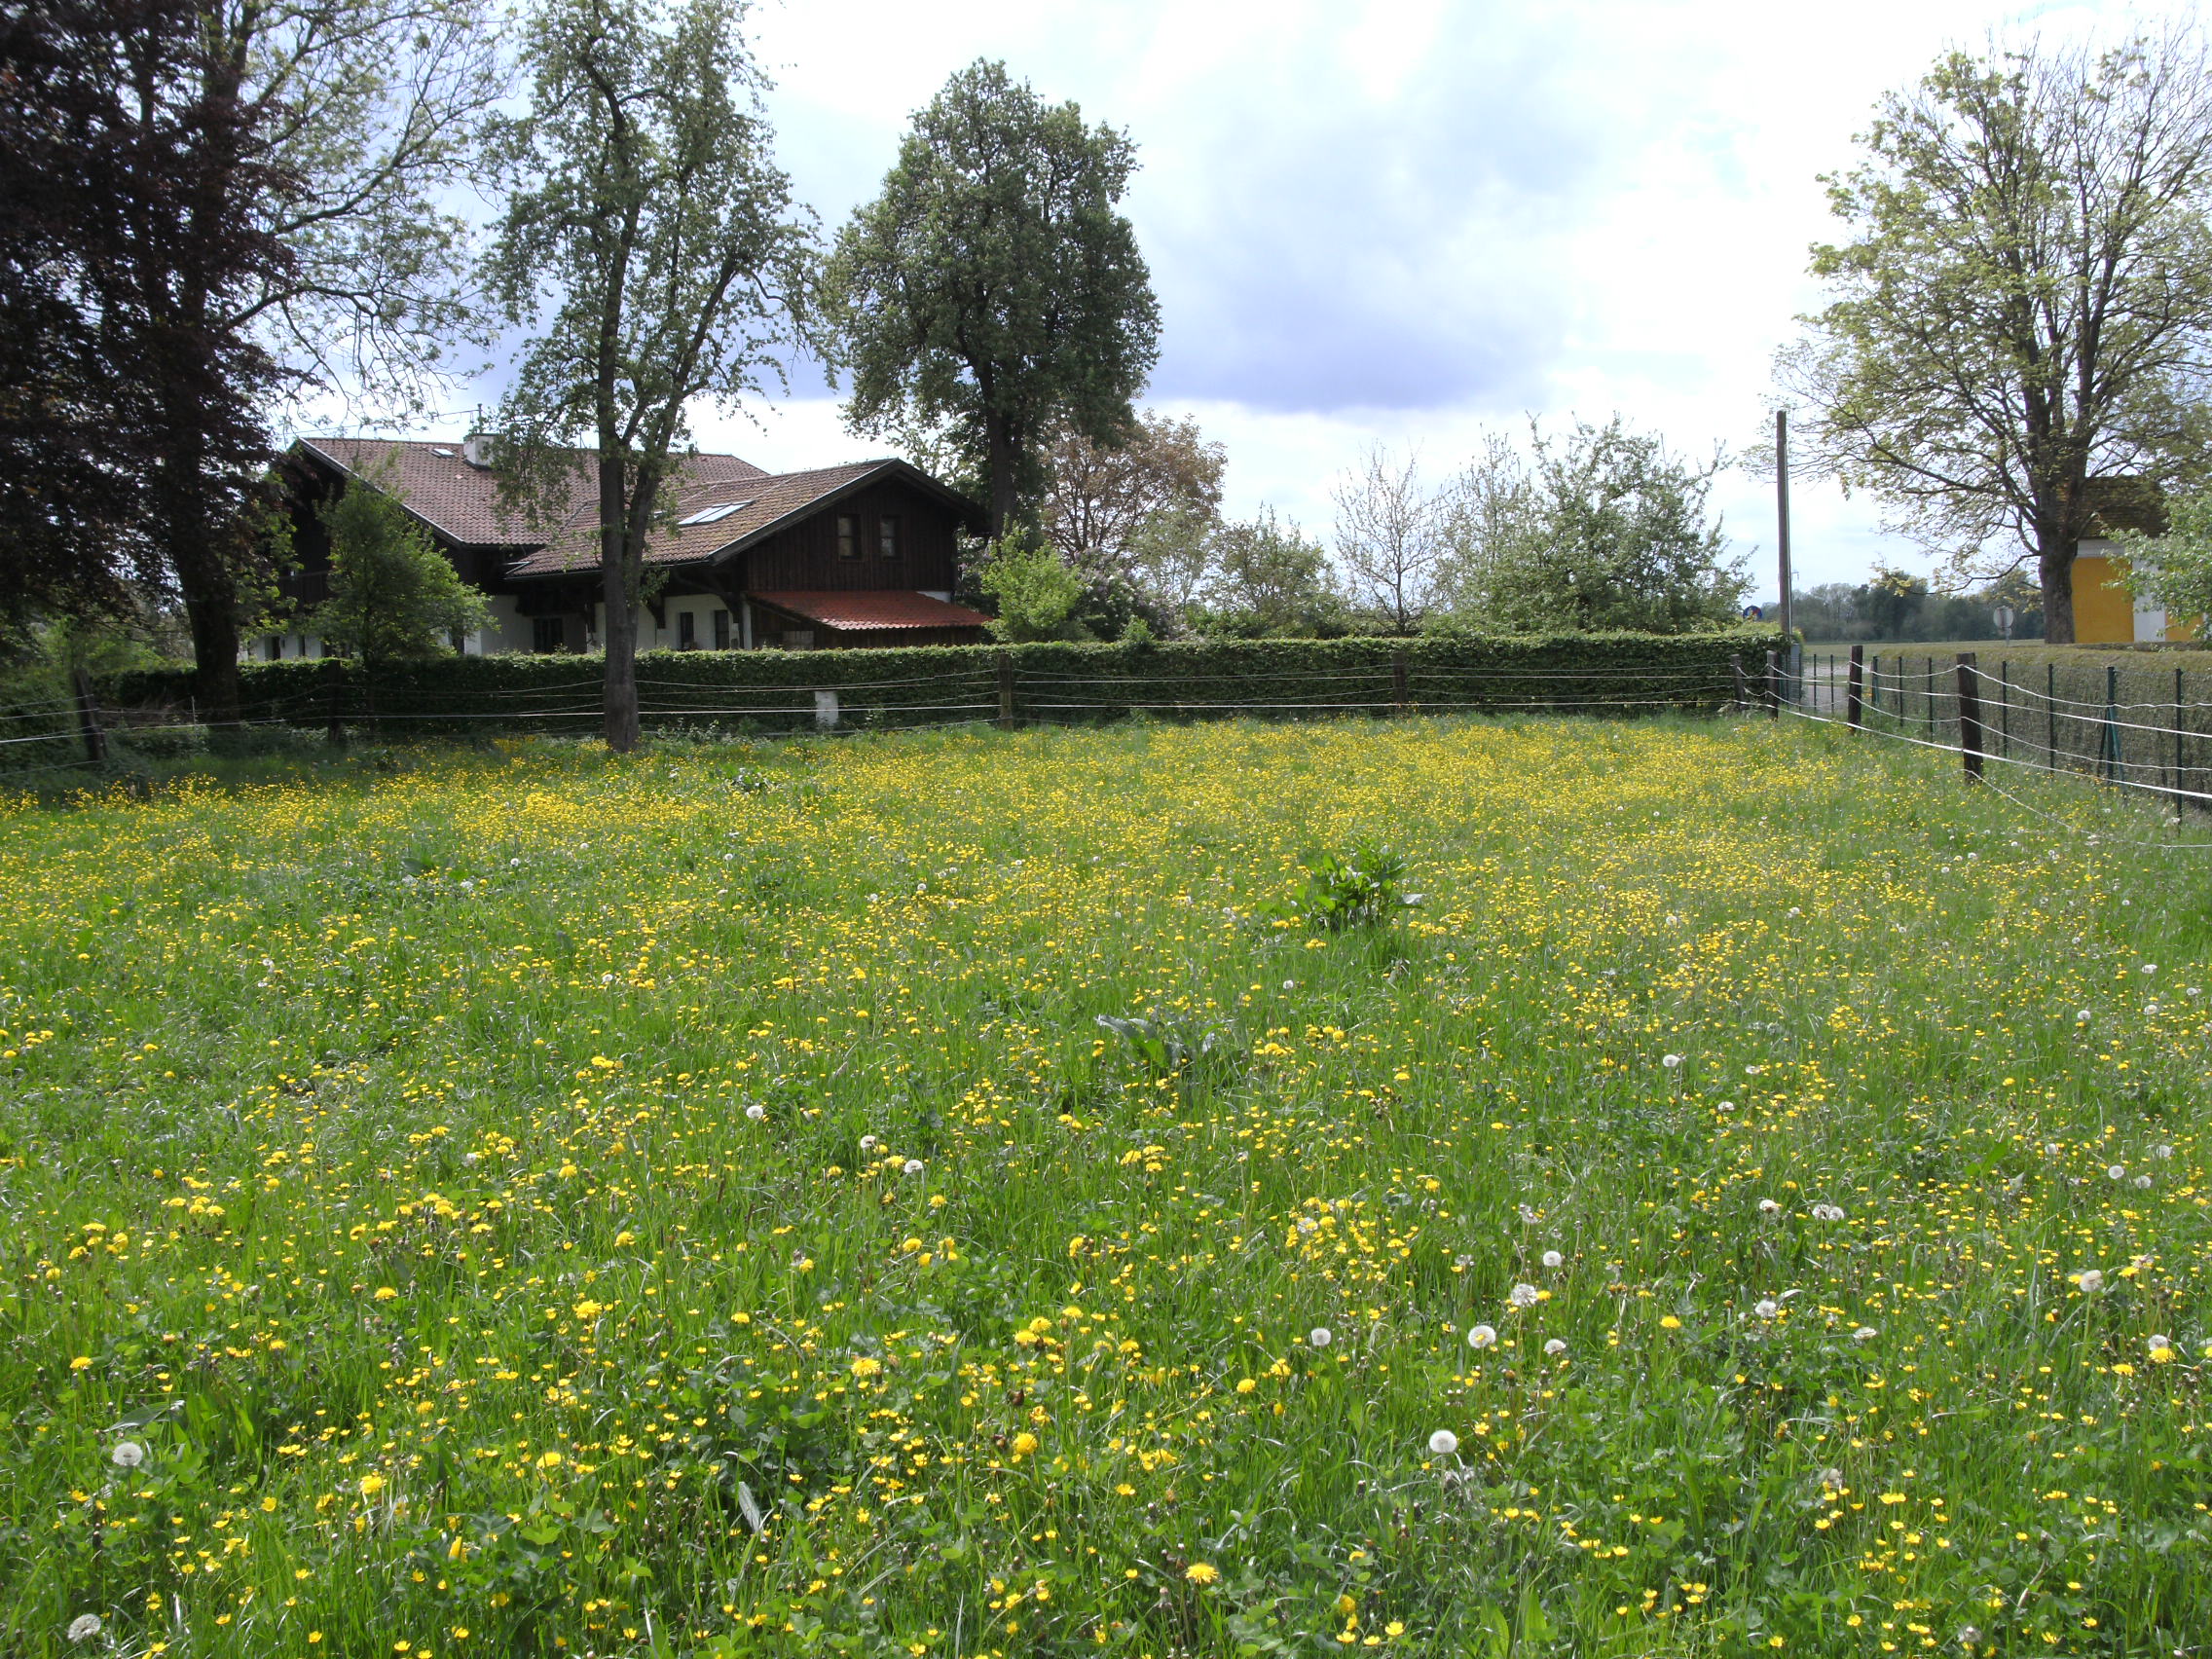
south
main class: Grassland
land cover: Grassland without tree/shrub cover
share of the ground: > 75 %
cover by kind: herbaceous plants 100 %
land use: Agriculture (excluding fallow land and kitchen gardens)
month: May
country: AT
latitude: 48.3345
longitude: 13.3583
